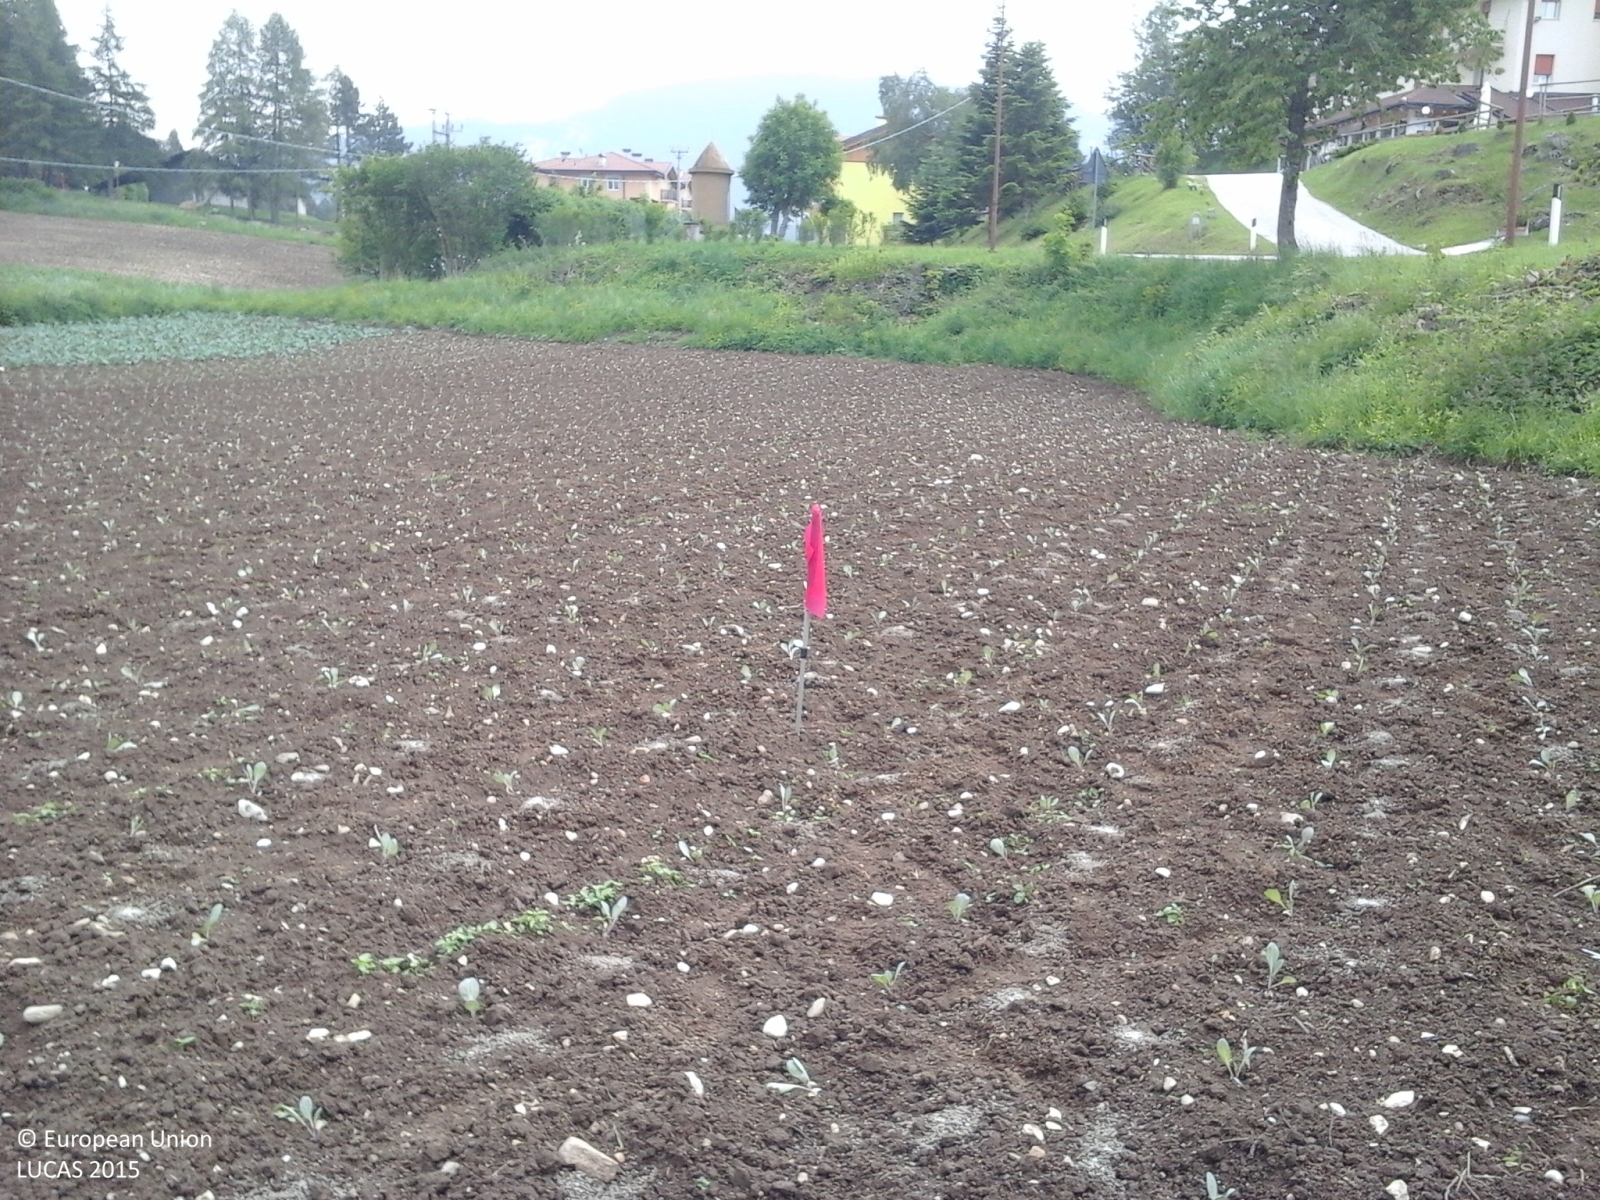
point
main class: Cropland
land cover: Other fresh vegetables
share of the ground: < 10 %
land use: Agriculture (excluding fallow land and kitchen gardens)
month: June
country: IT
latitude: 45.8967
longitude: 10.9394
